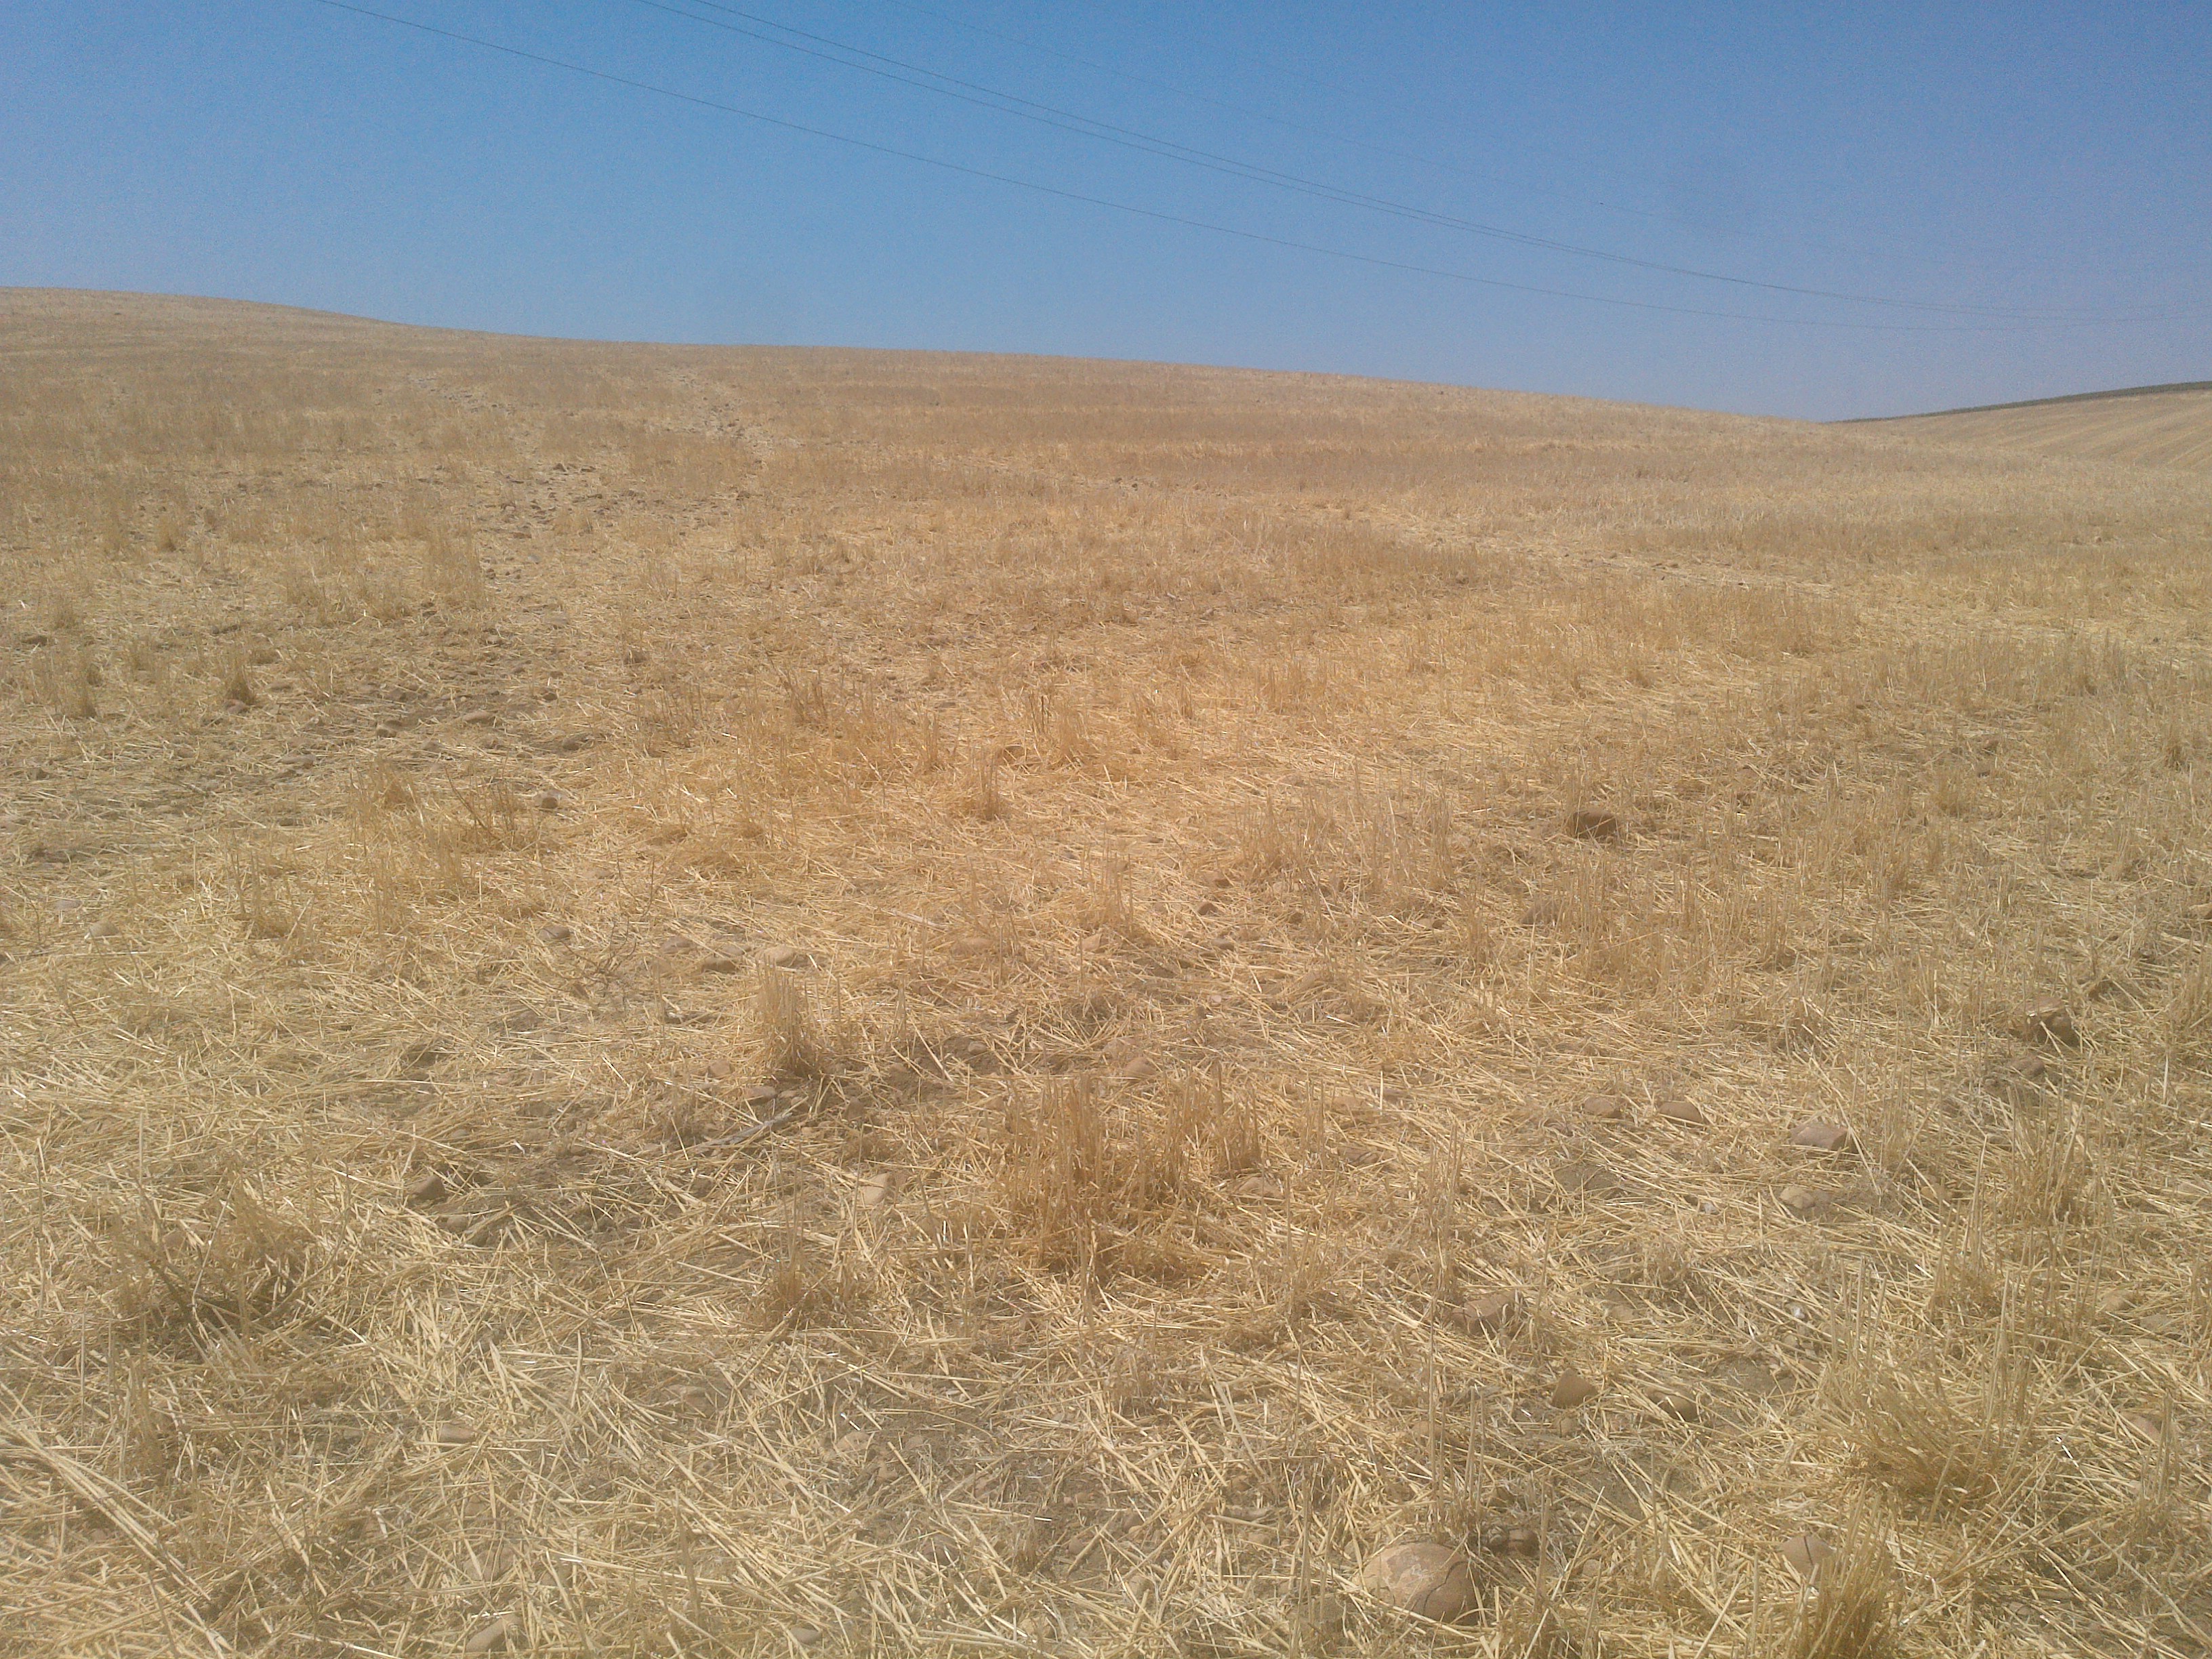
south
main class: Cropland
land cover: Durum wheat
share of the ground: < 10 %
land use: Agriculture (excluding fallow land and kitchen gardens)
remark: Harvested field
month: June
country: ES
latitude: 37.7916
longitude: -4.9481
